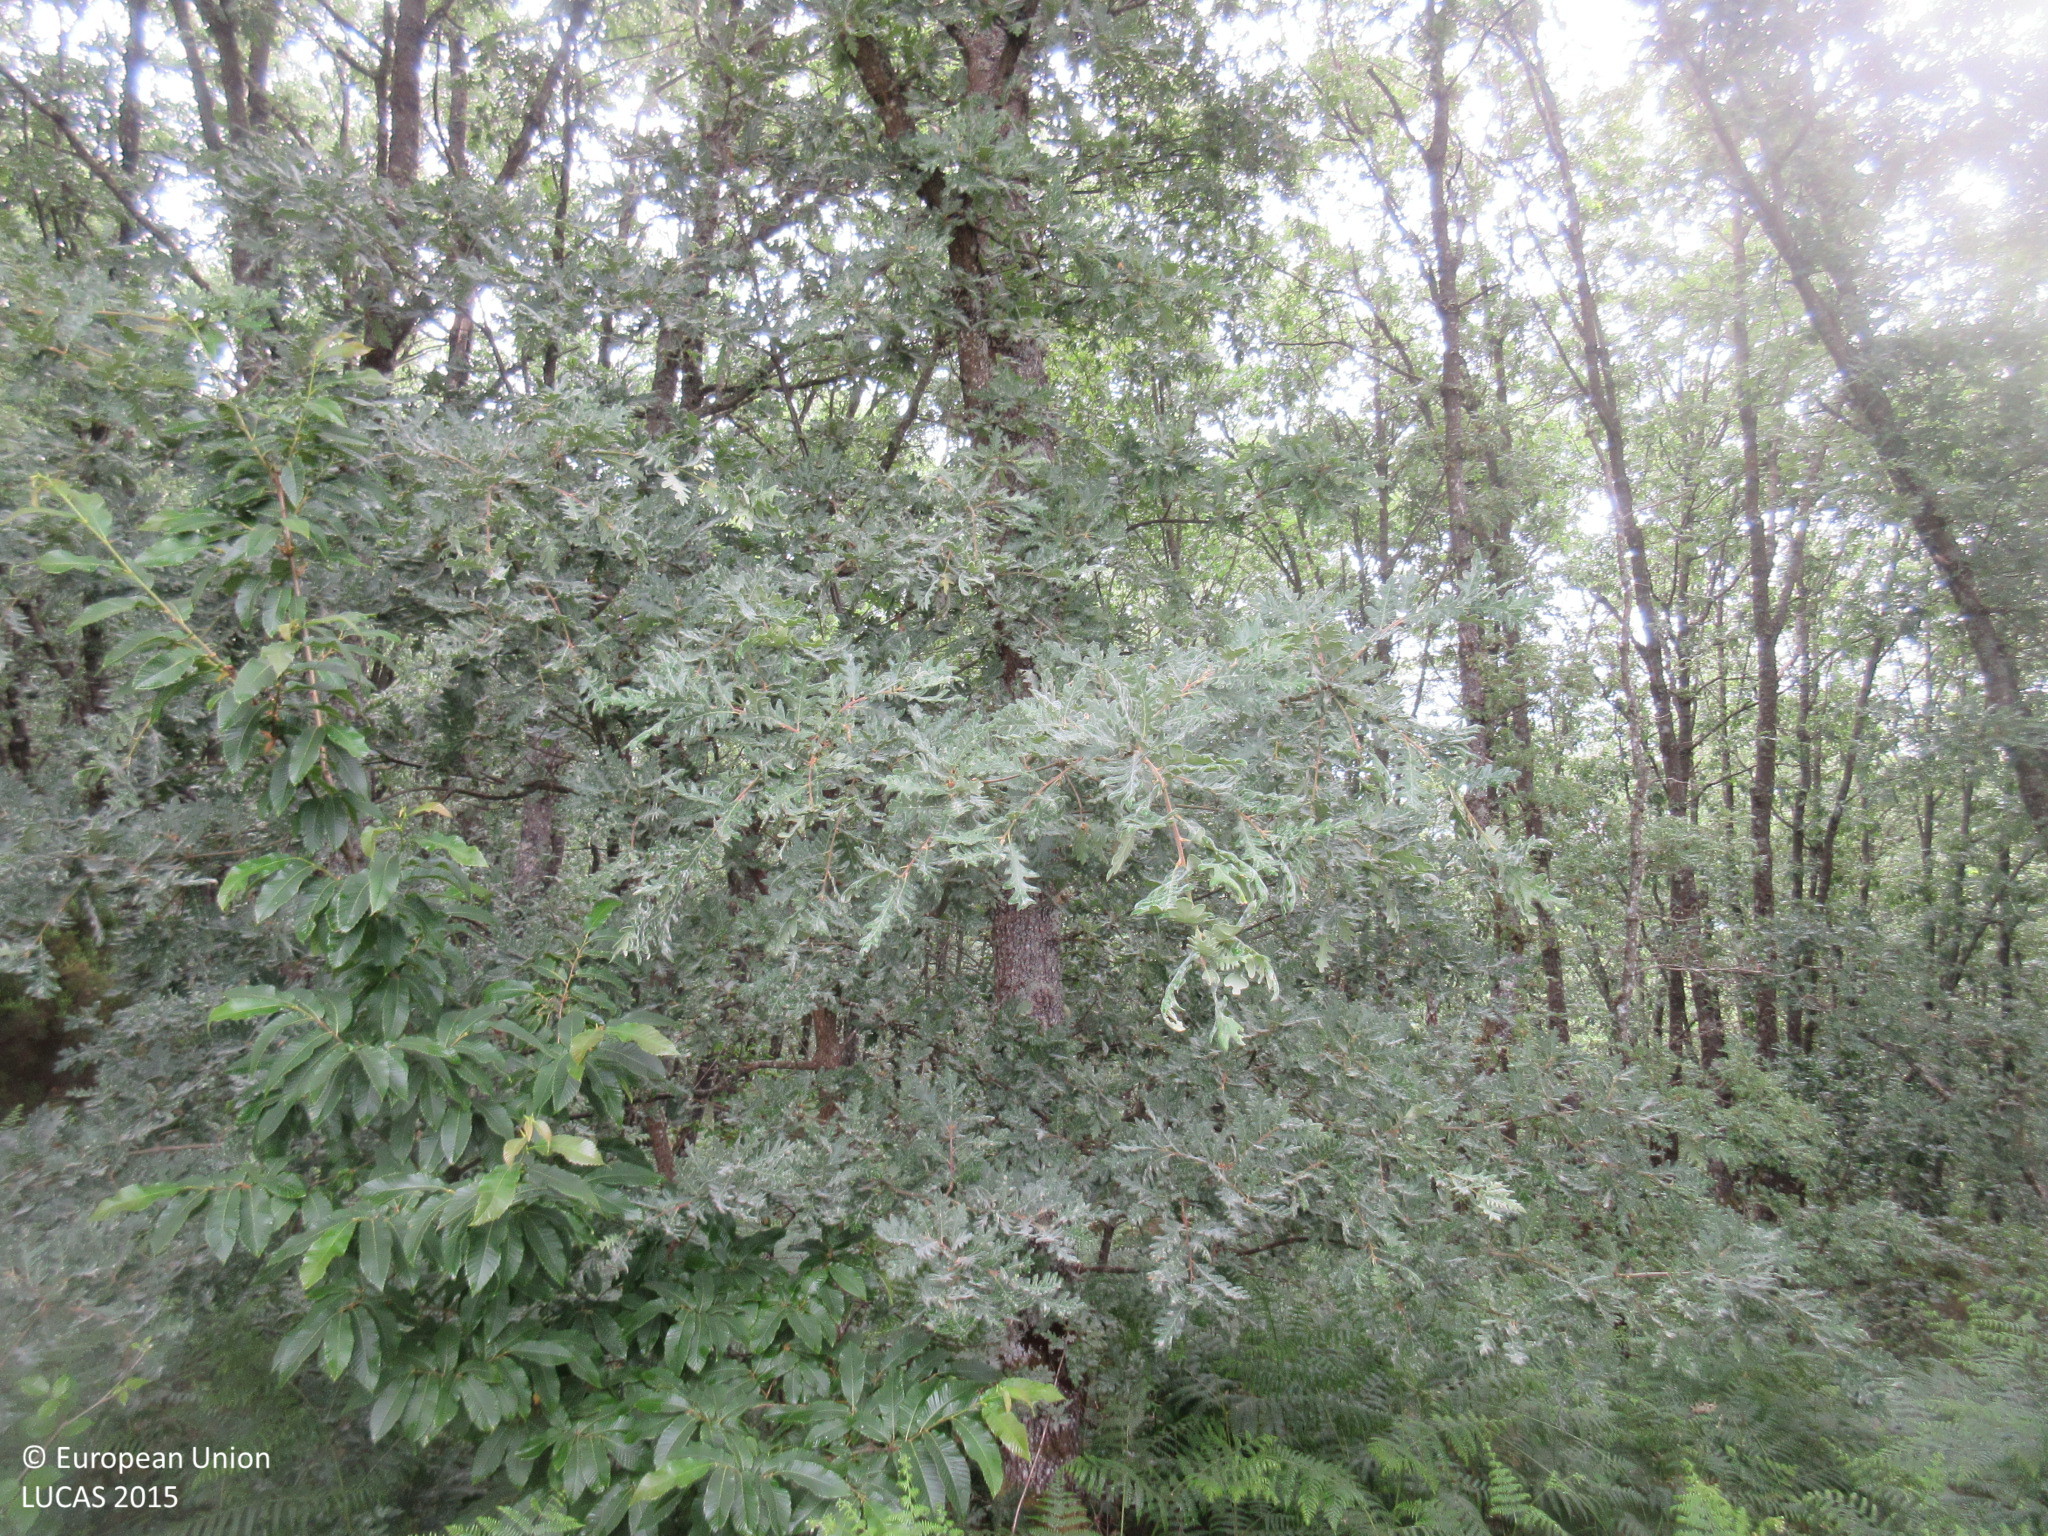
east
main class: Woodland
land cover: Broadleaved woodland
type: acidophilous oak and oak-birch forest
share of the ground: > 75 %
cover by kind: broadleaved forest trees 95 %, shrubs 5 %
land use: Forestry
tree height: > 5 m
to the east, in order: Broadleaved woodland; Pine dominated coniferous woodland; Tracks; Pine dominated coniferous woodland
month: June
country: ES
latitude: 43.0010
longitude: -7.1540
